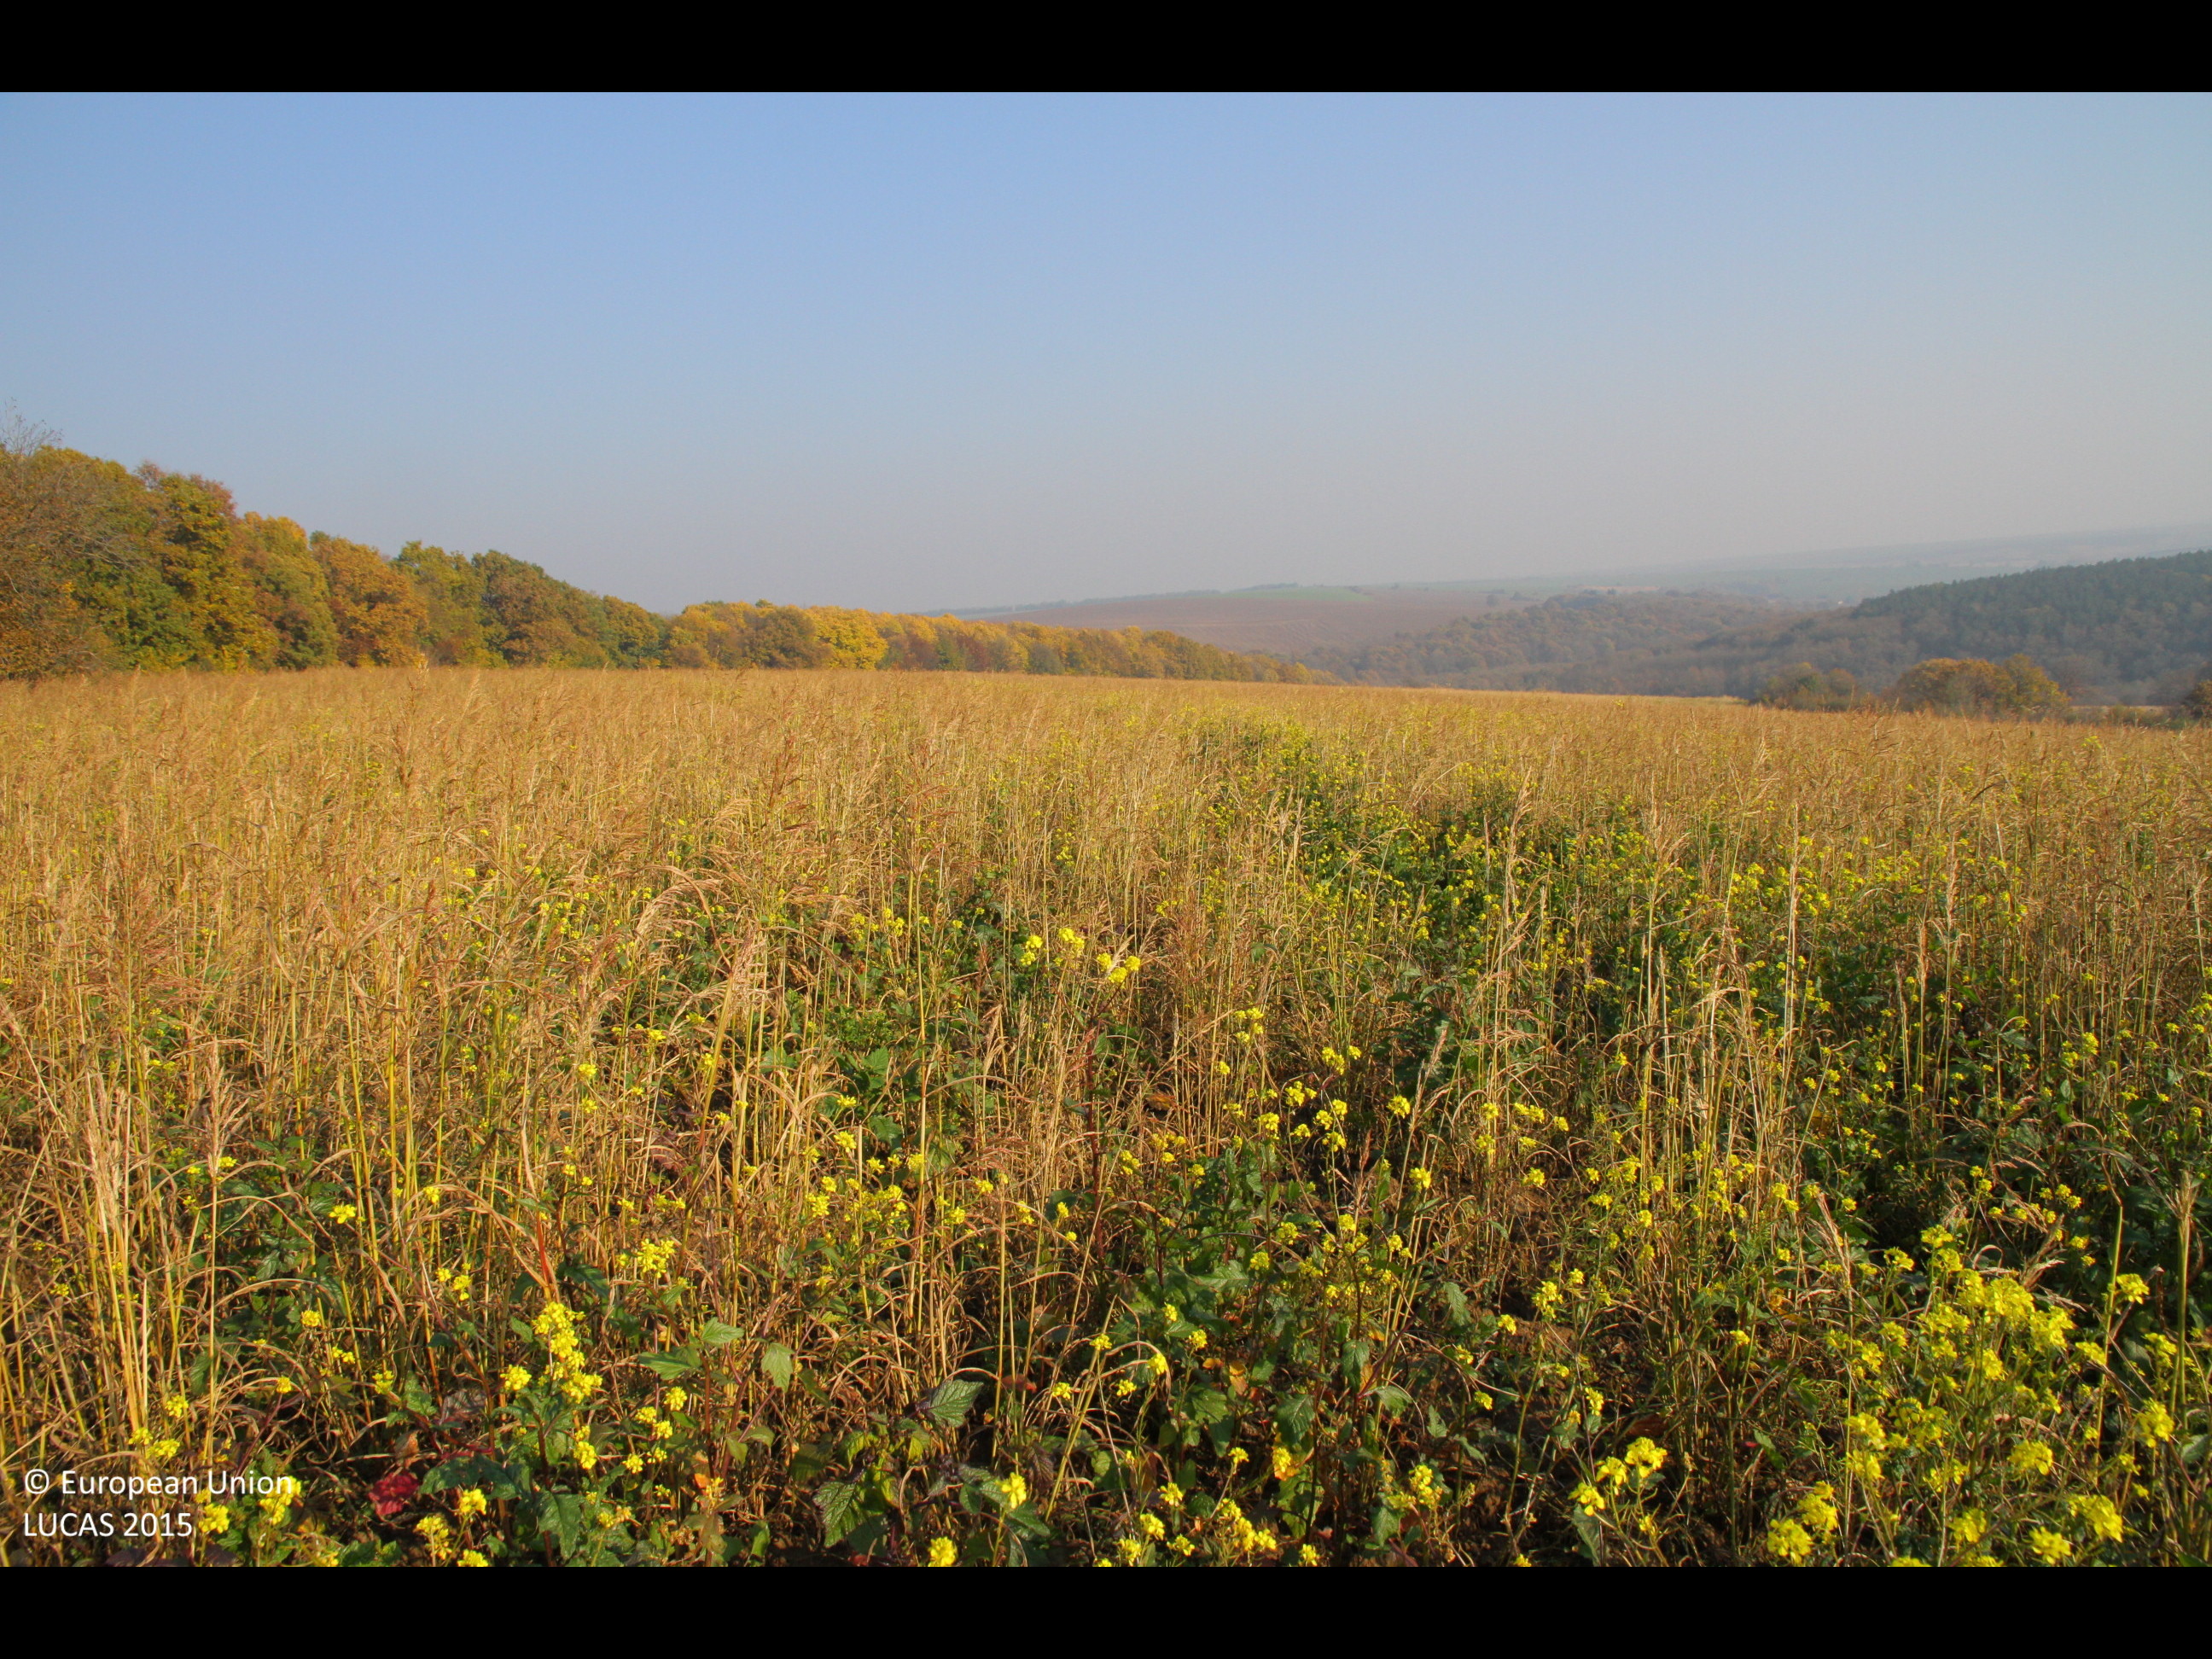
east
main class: Cropland
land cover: Rape and turnip rape
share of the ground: > 75 %
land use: Agriculture (excluding fallow land and kitchen gardens)
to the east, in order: Rape and turnip rape
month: November
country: BG
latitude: 43.7050
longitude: 26.3473
